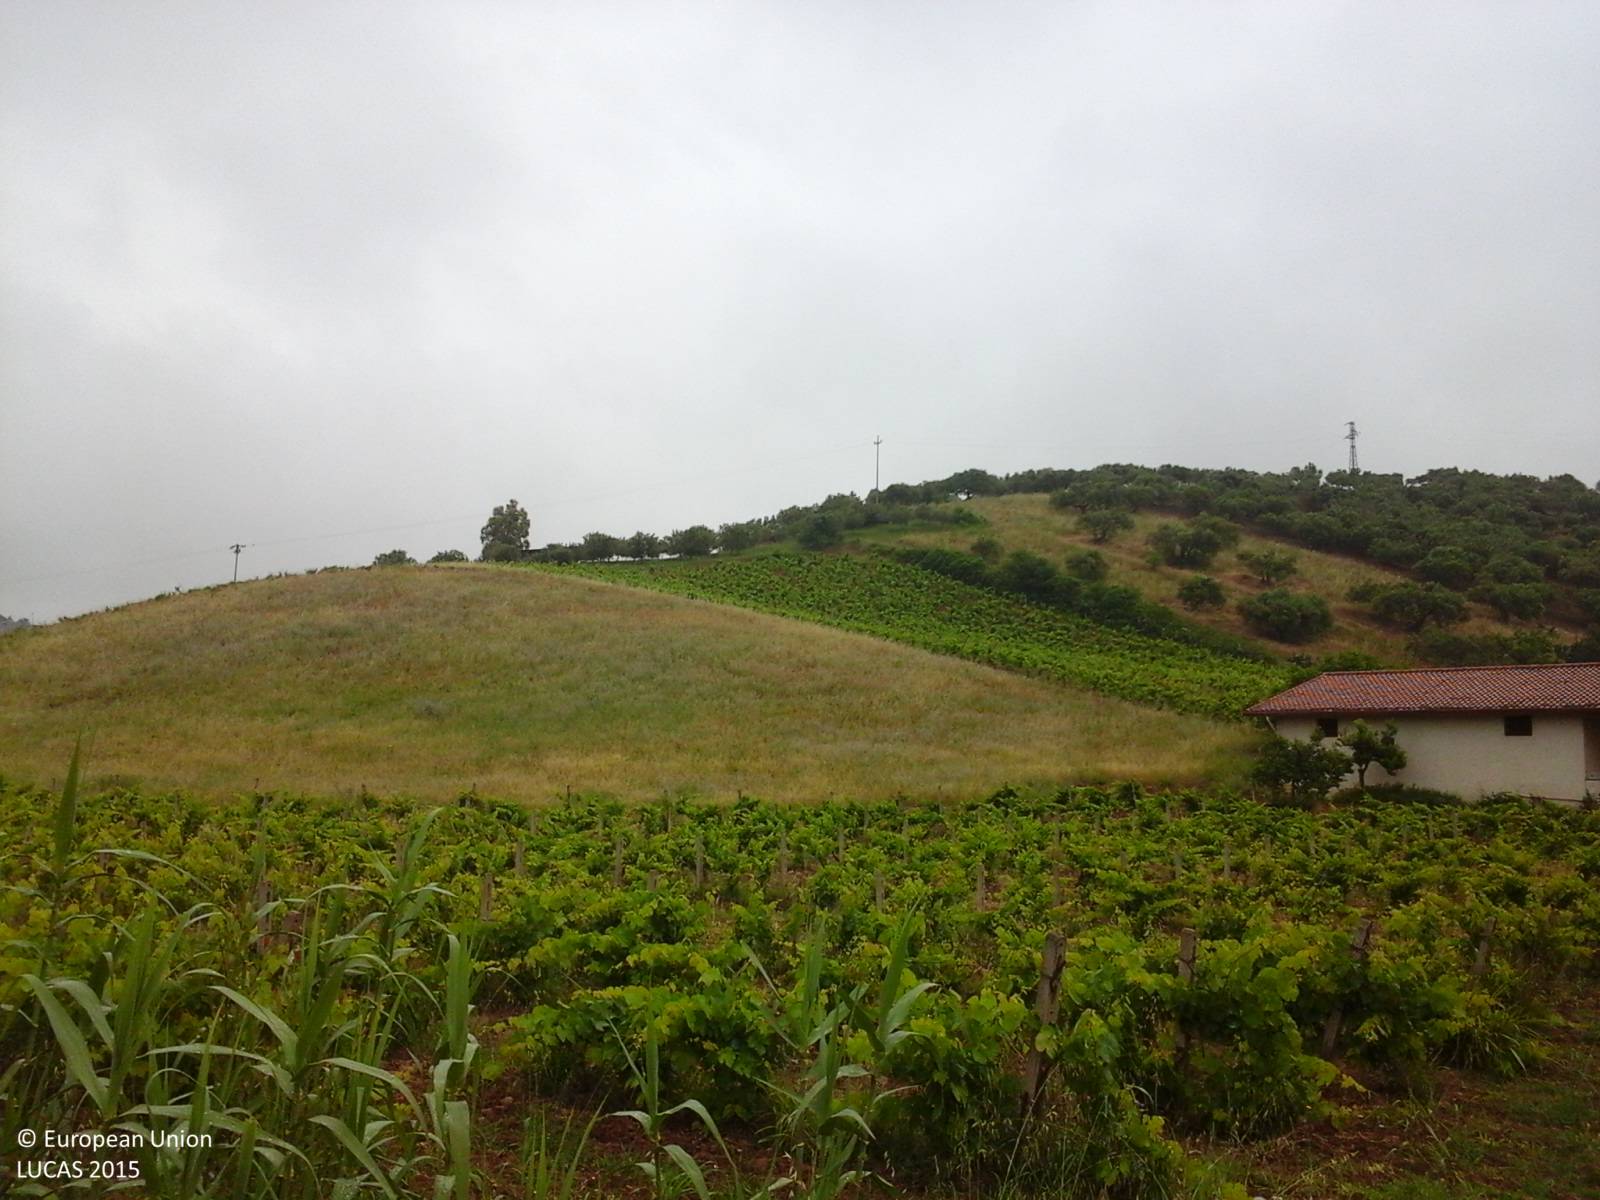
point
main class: Cropland
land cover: Vineyards
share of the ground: > 75 %
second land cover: Other bare soil
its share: > 75 %
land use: Agriculture (excluding fallow land and kitchen gardens)
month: May
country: IT
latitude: 37.9496
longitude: 13.1524
